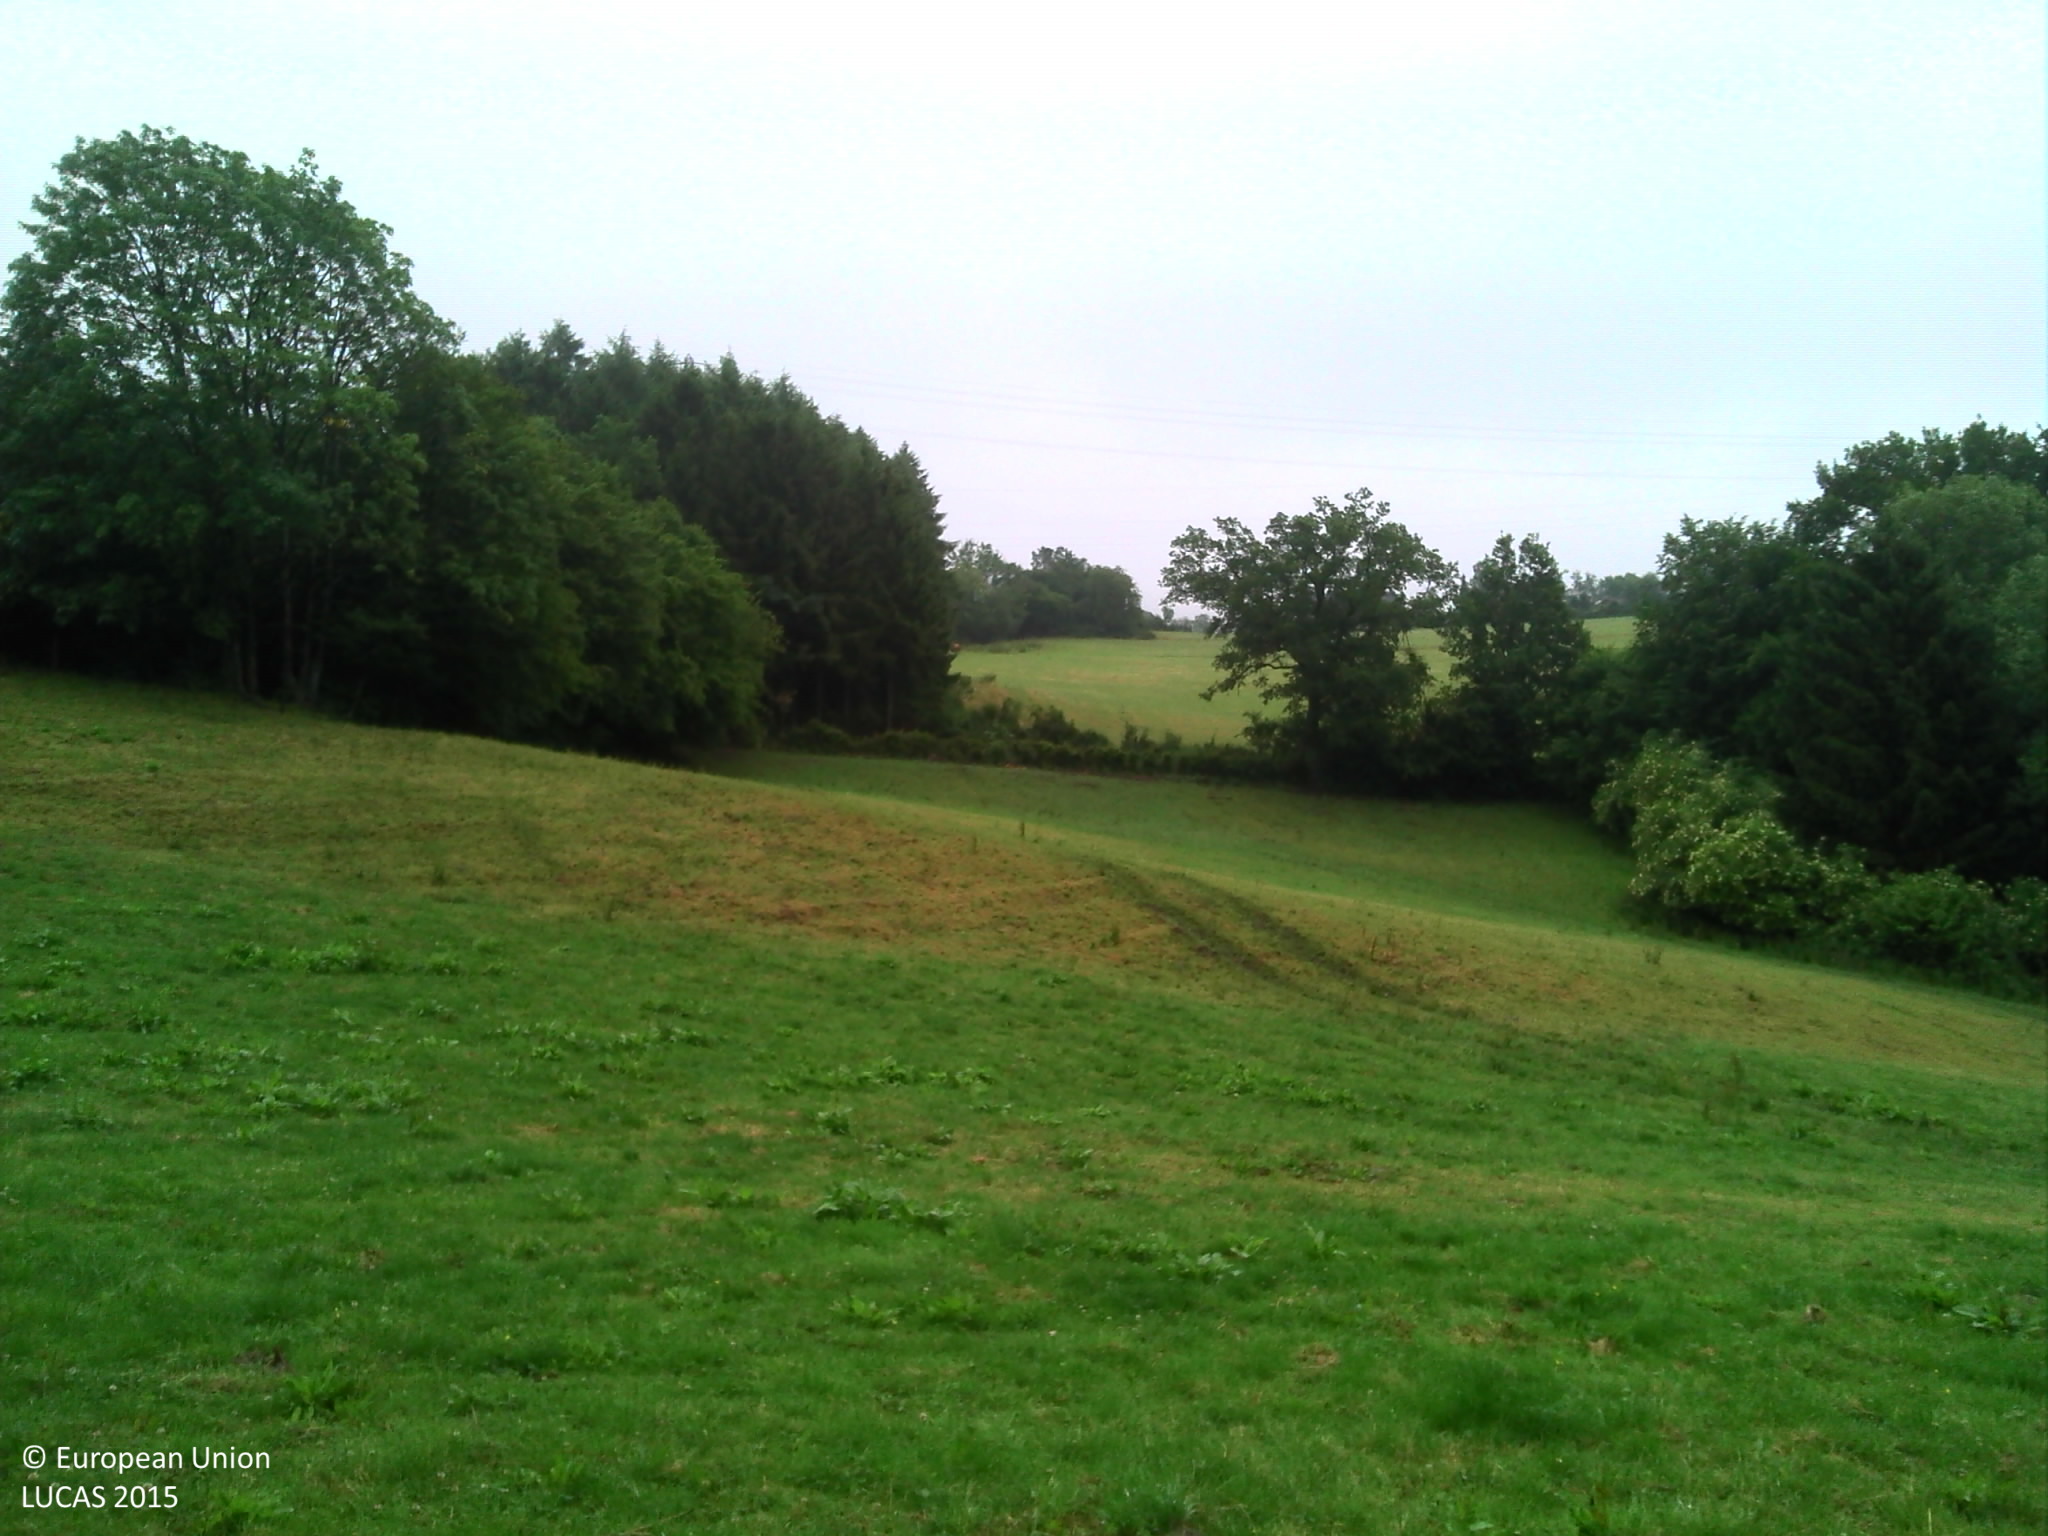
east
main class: Grassland
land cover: Grassland without tree/shrub cover
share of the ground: > 75 %
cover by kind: herbaceous plants 100 %
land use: Agriculture (excluding fallow land and kitchen gardens)
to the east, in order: Grassland without tree/shrub cover; Fences; Managed hedges; Grass margins; Paved roads, cycling and walking lanes; Spontaneously vegetated surfaces; Fences; Grassland without tree/shrub cover; Electric lines; Grassland without tree/shrub cover
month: June
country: BE
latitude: 50.2585
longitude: 5.5238
